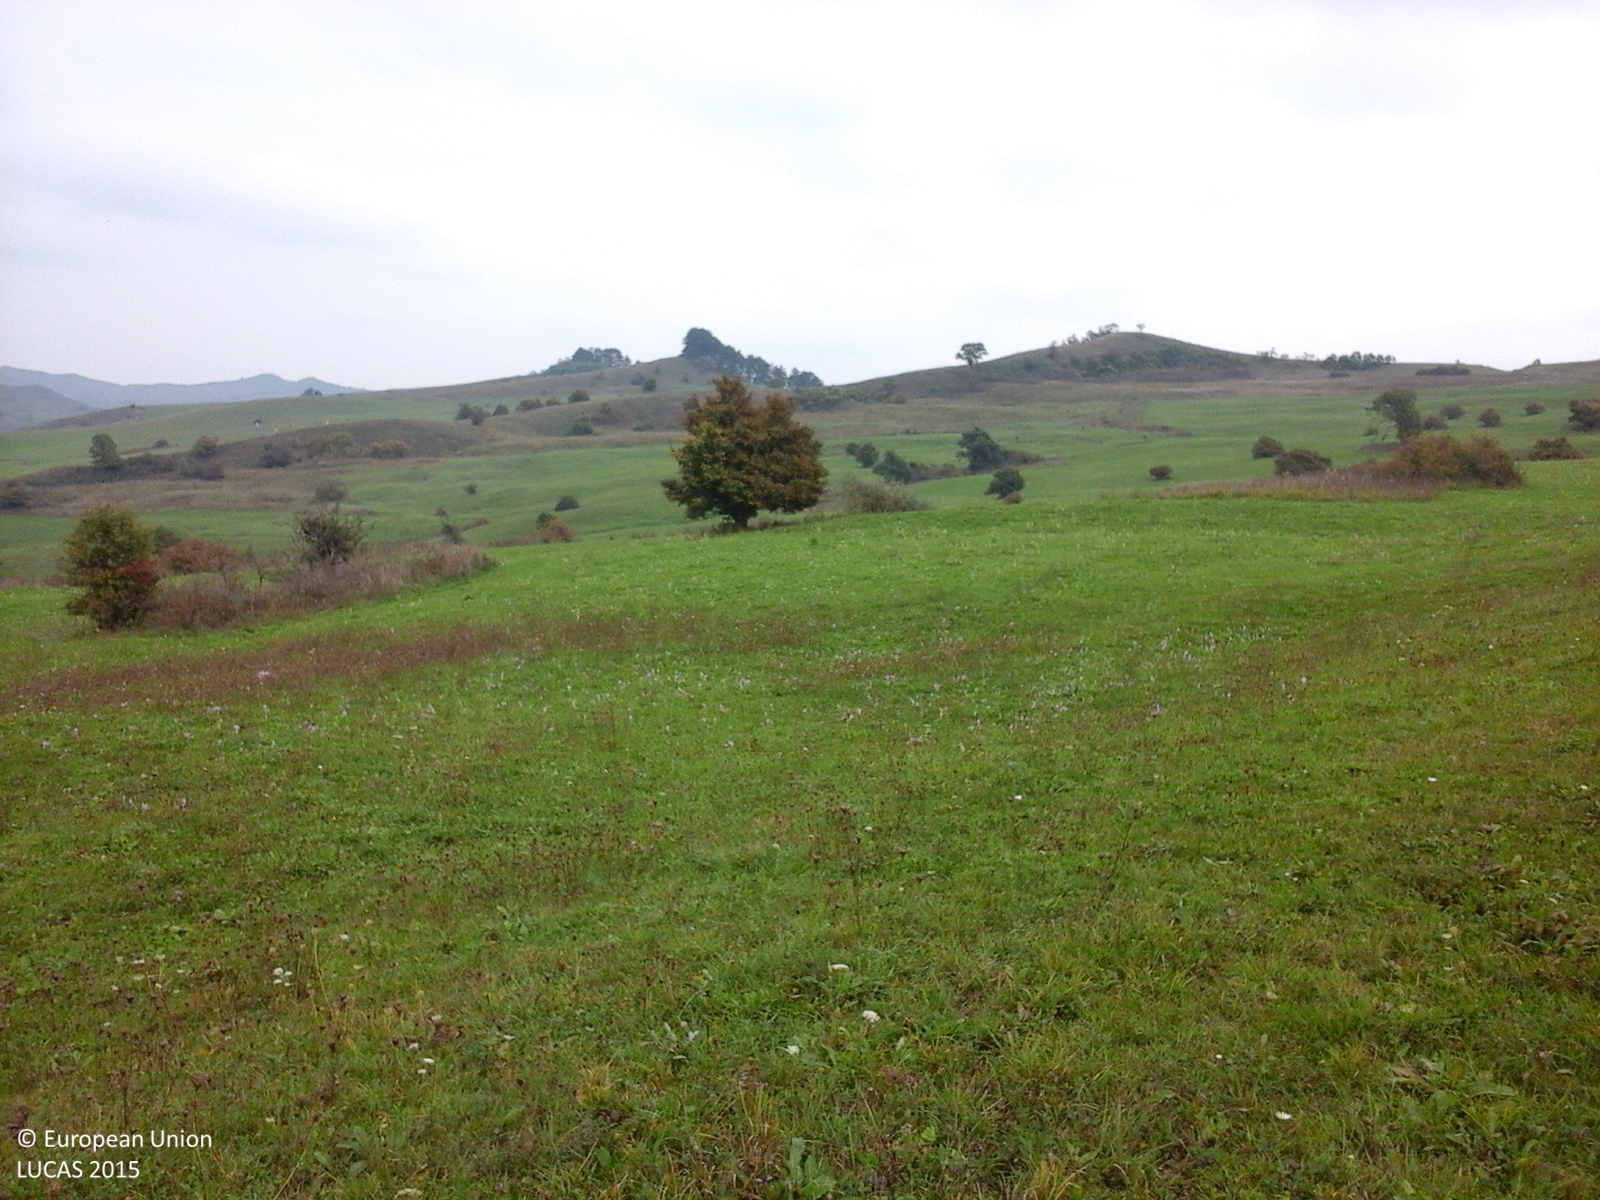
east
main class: Grassland
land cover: Grassland without tree/shrub cover
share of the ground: > 75 %
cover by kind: herbaceous plants 100 %
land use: Agriculture (excluding fallow land and kitchen gardens)
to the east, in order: Grassland without tree/shrub cover; Single bushes/trees; Grassland without tree/shrub cover; Grassland with sparse tree/shrub cover; Grassland without tree/shrub cover
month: October
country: RO
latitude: 46.2601
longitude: 24.8429
